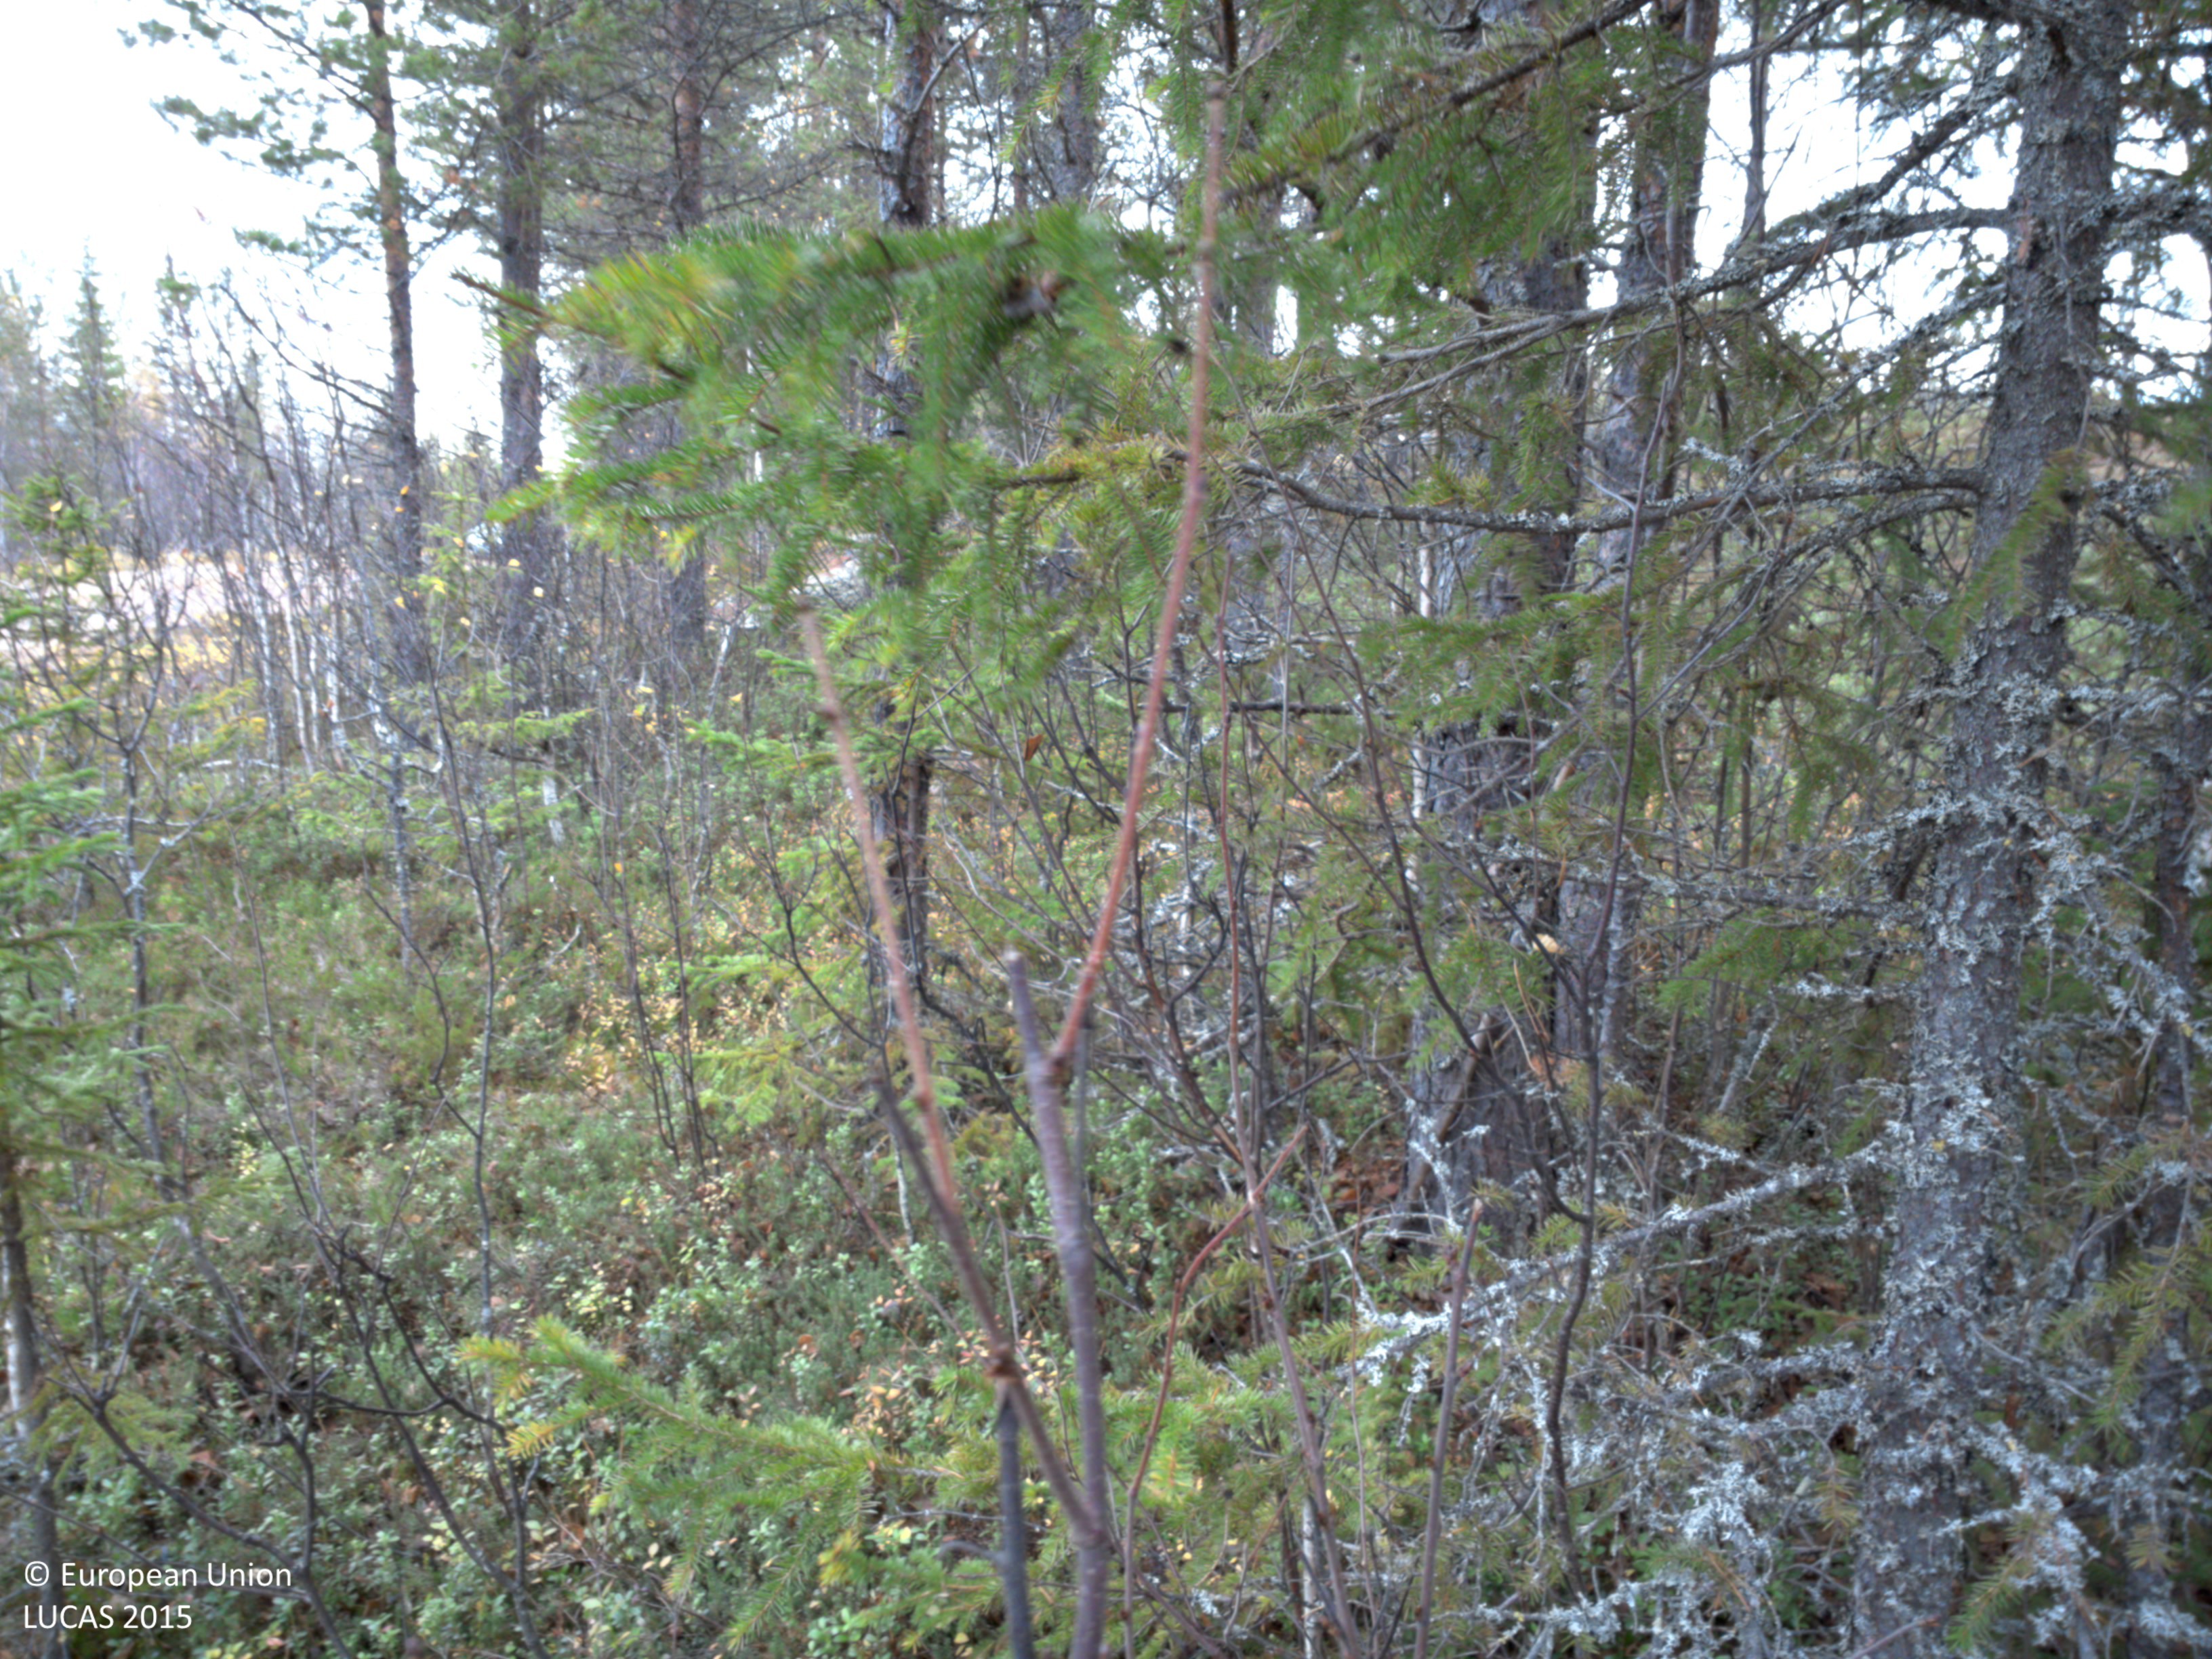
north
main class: Woodland
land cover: Pine dominated mixed woodland
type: boreal forest
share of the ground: > 75 %
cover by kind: coniferous forest trees 60 %, broadleaved forest trees 25 %, shrubs 10 %, lichens and mosses 5 %
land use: Forestry
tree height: > 5 m
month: October
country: SE
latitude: 65.0369
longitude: 18.2669
